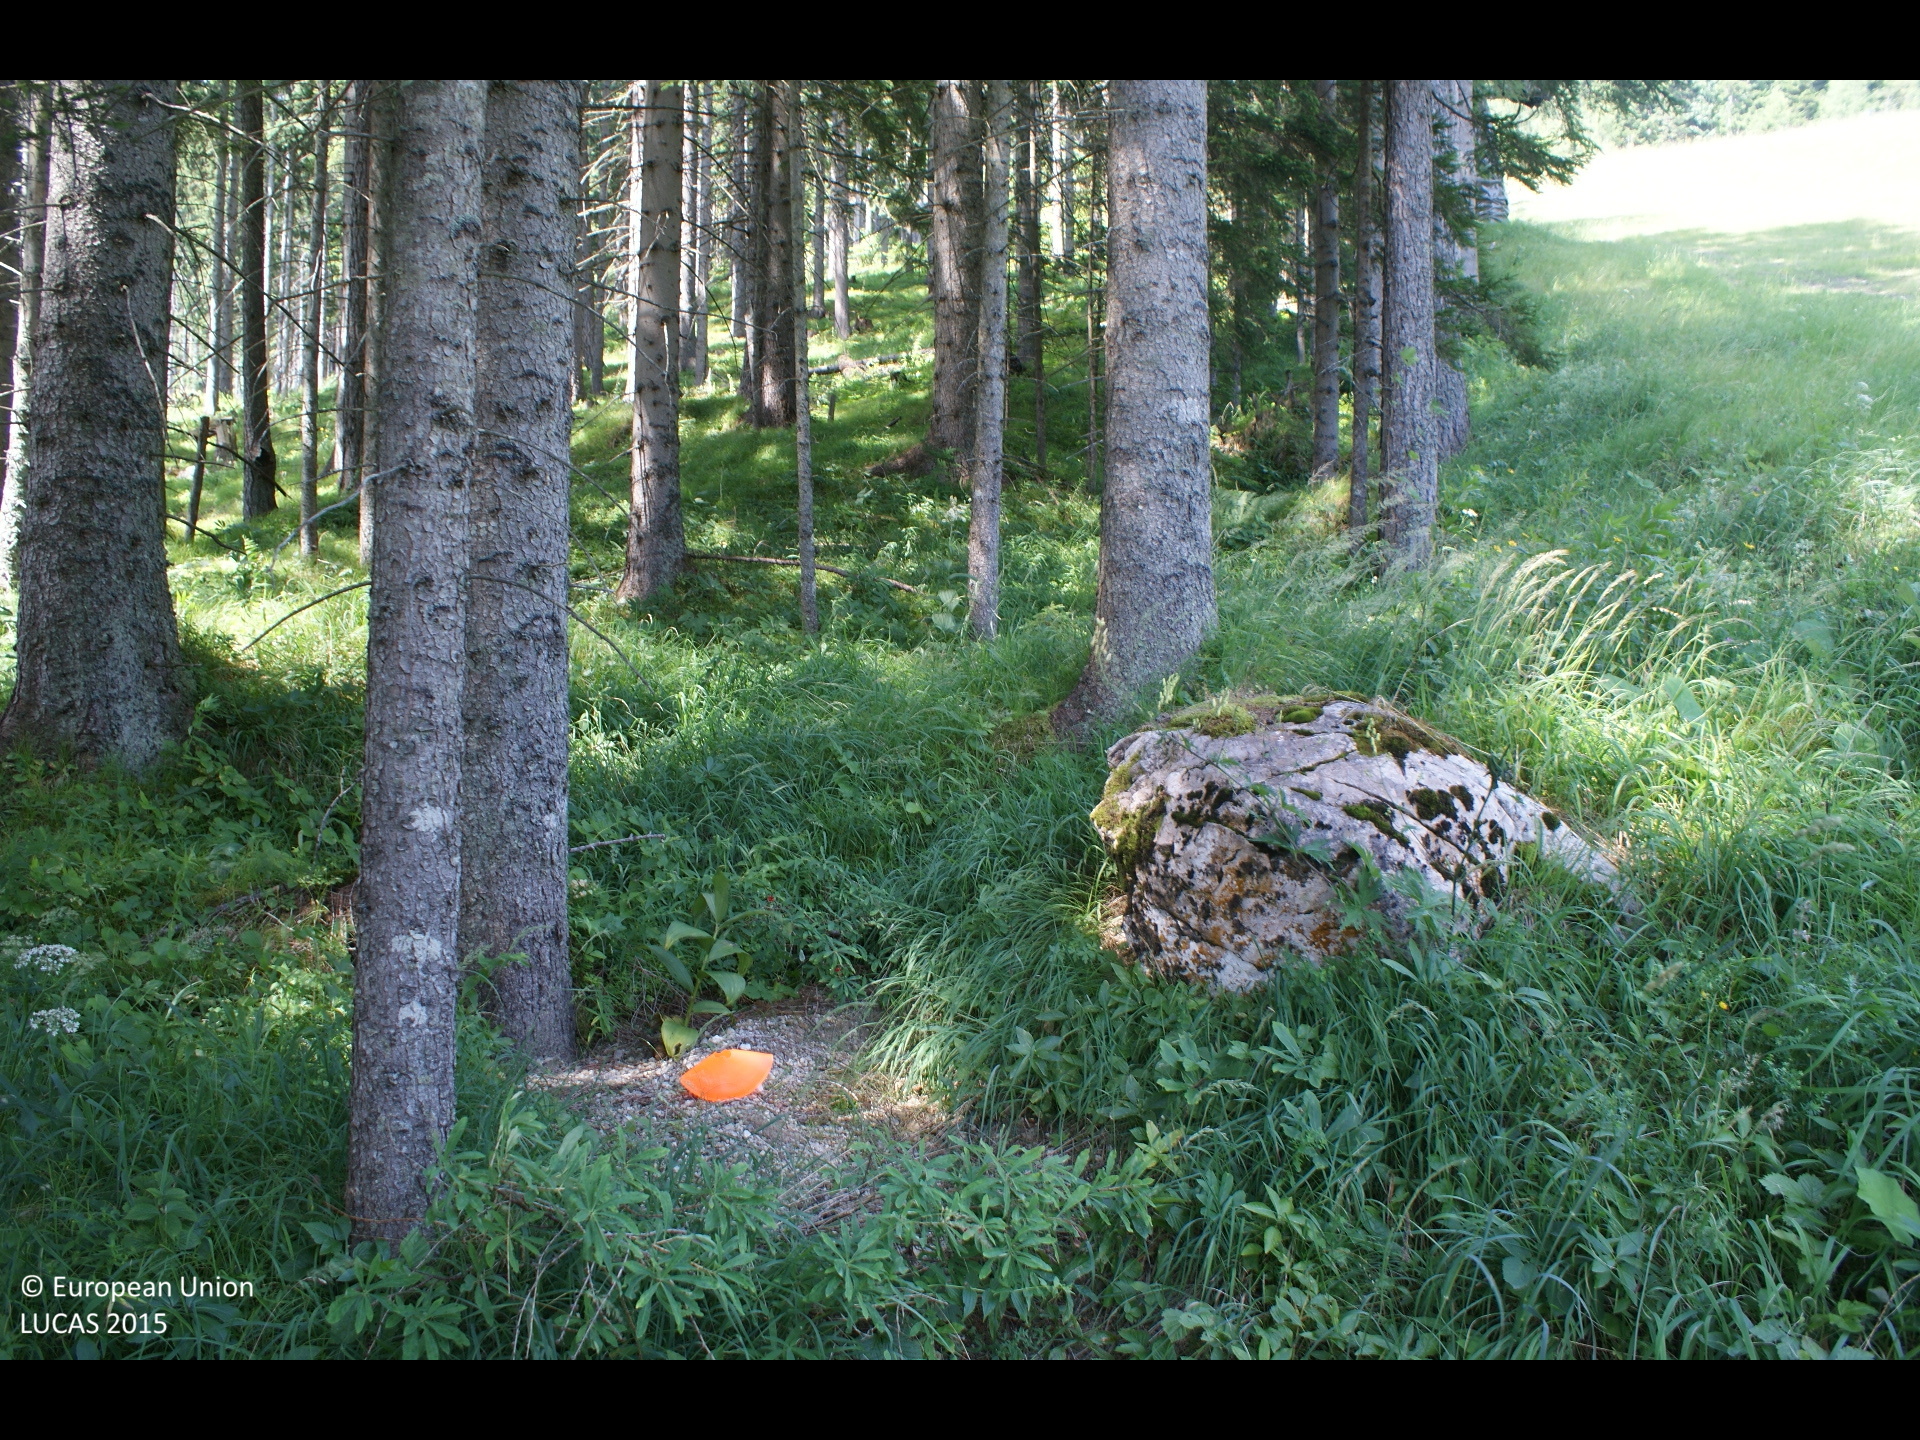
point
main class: Woodland
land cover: Spruce dominated coniferous woodland
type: alpine coniferous forest
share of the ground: > 75 %
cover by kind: coniferous forest trees 100 %
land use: Forestry
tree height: > 5 m
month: July
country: AT
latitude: 47.8087
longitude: 15.2757
